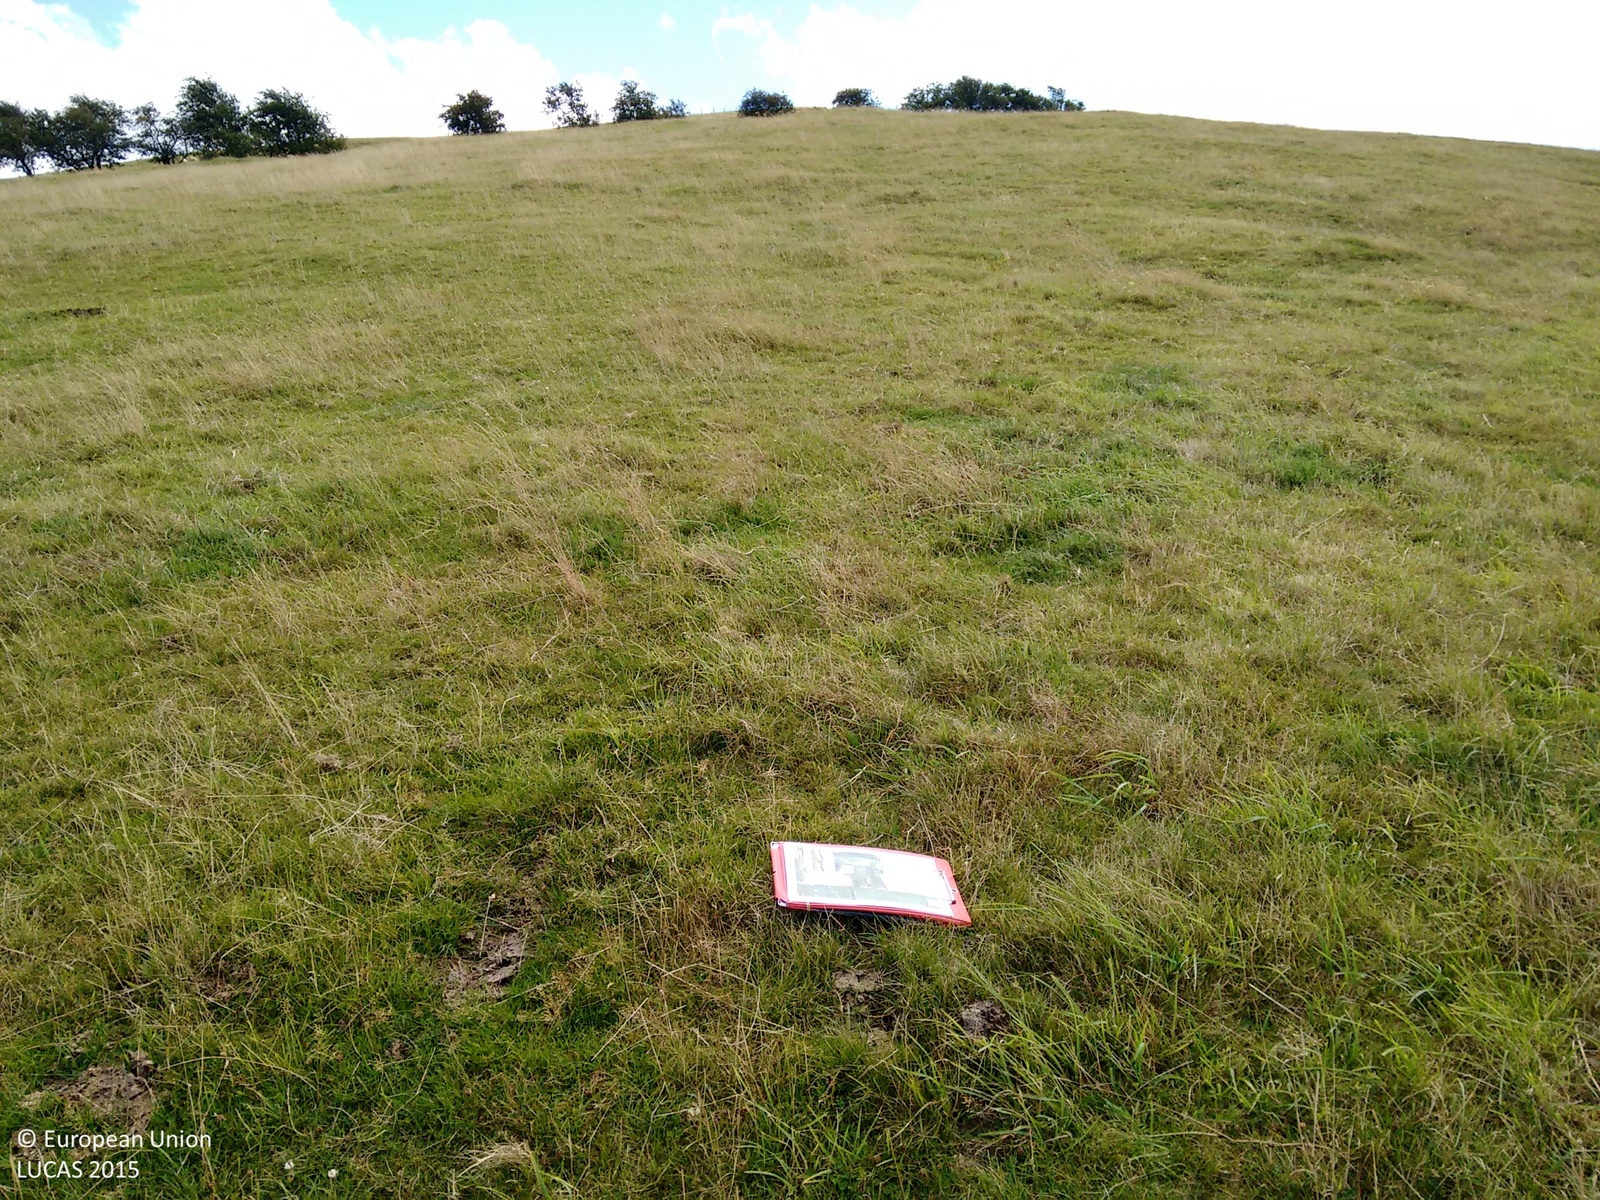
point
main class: Grassland
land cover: Grassland without tree/shrub cover
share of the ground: > 75 %
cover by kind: herbaceous plants 100 %
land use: Agriculture (excluding fallow land and kitchen gardens)
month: August
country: GB
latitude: 53.0875
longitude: -3.2634
